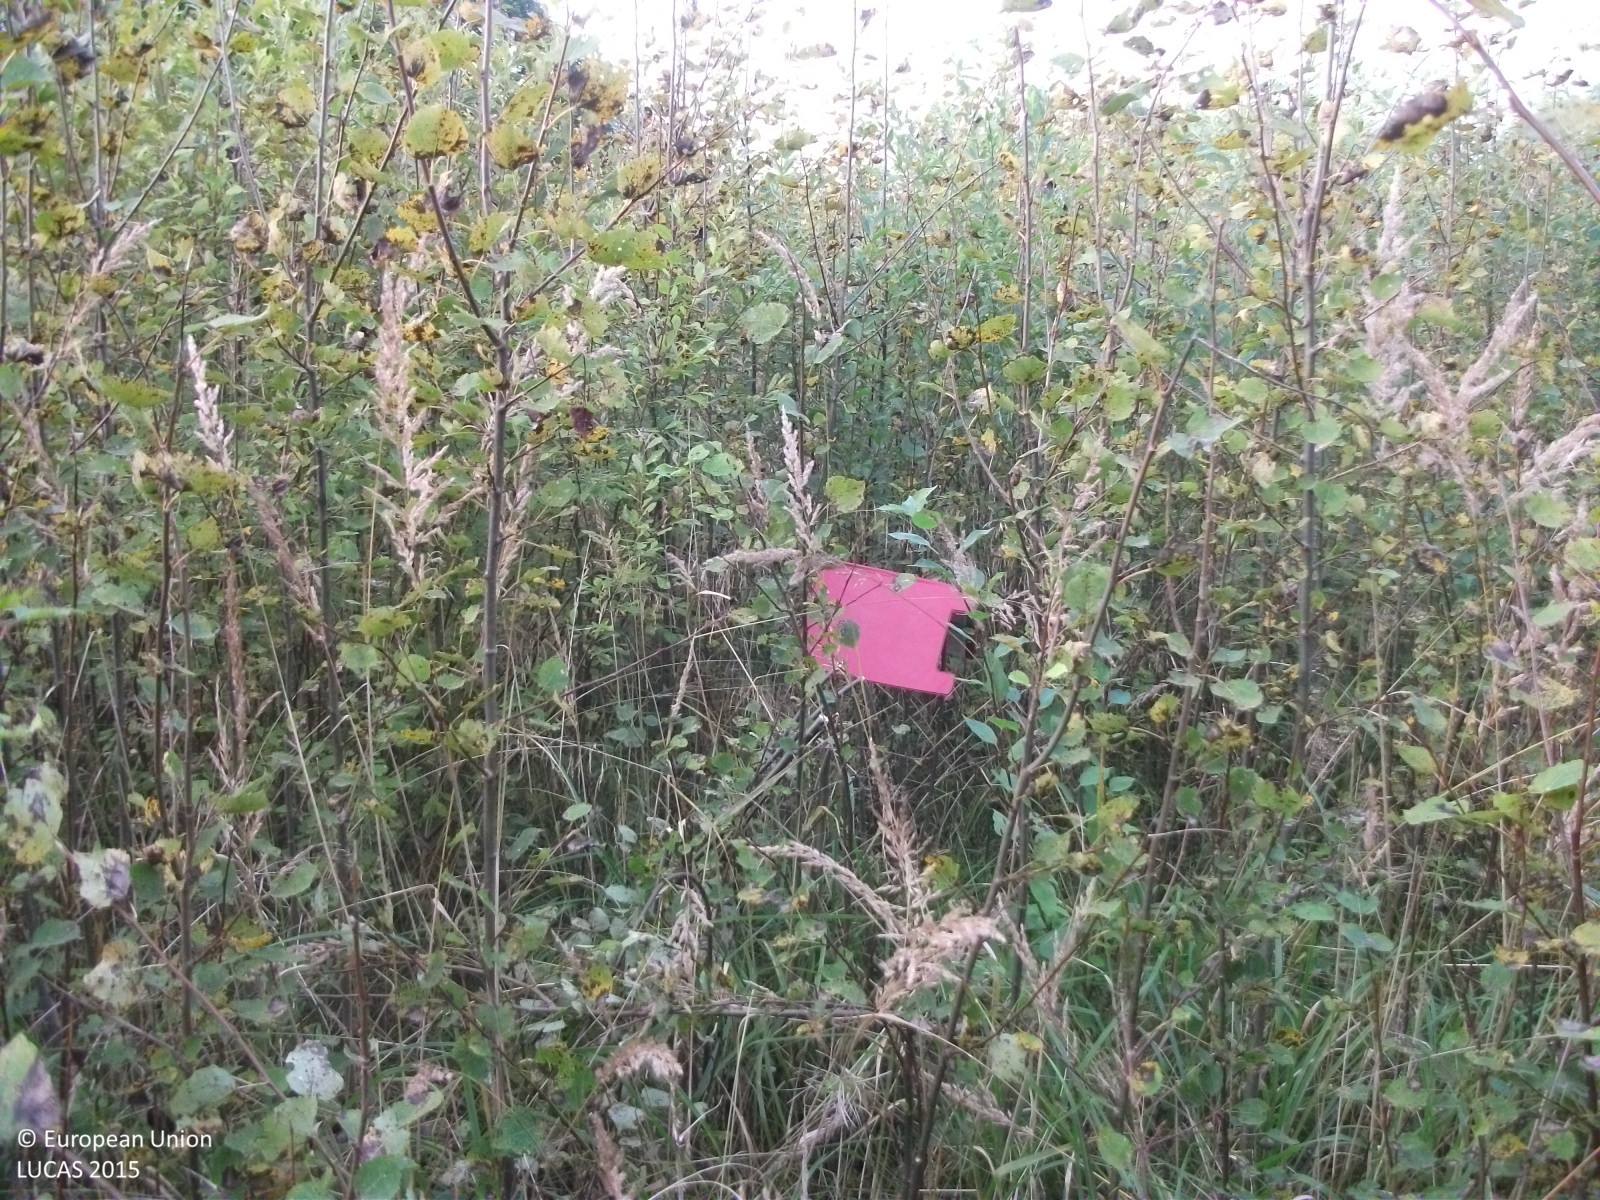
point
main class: Woodland
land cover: Broadleaved woodland
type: non-riverine alder, birch or aspen forest
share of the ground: > 75 %
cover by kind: broadleaved forest trees 85 %, shrubs 15 %
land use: Forestry
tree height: < 5 m
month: September
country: LV
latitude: 57.5853
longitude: 24.5601
